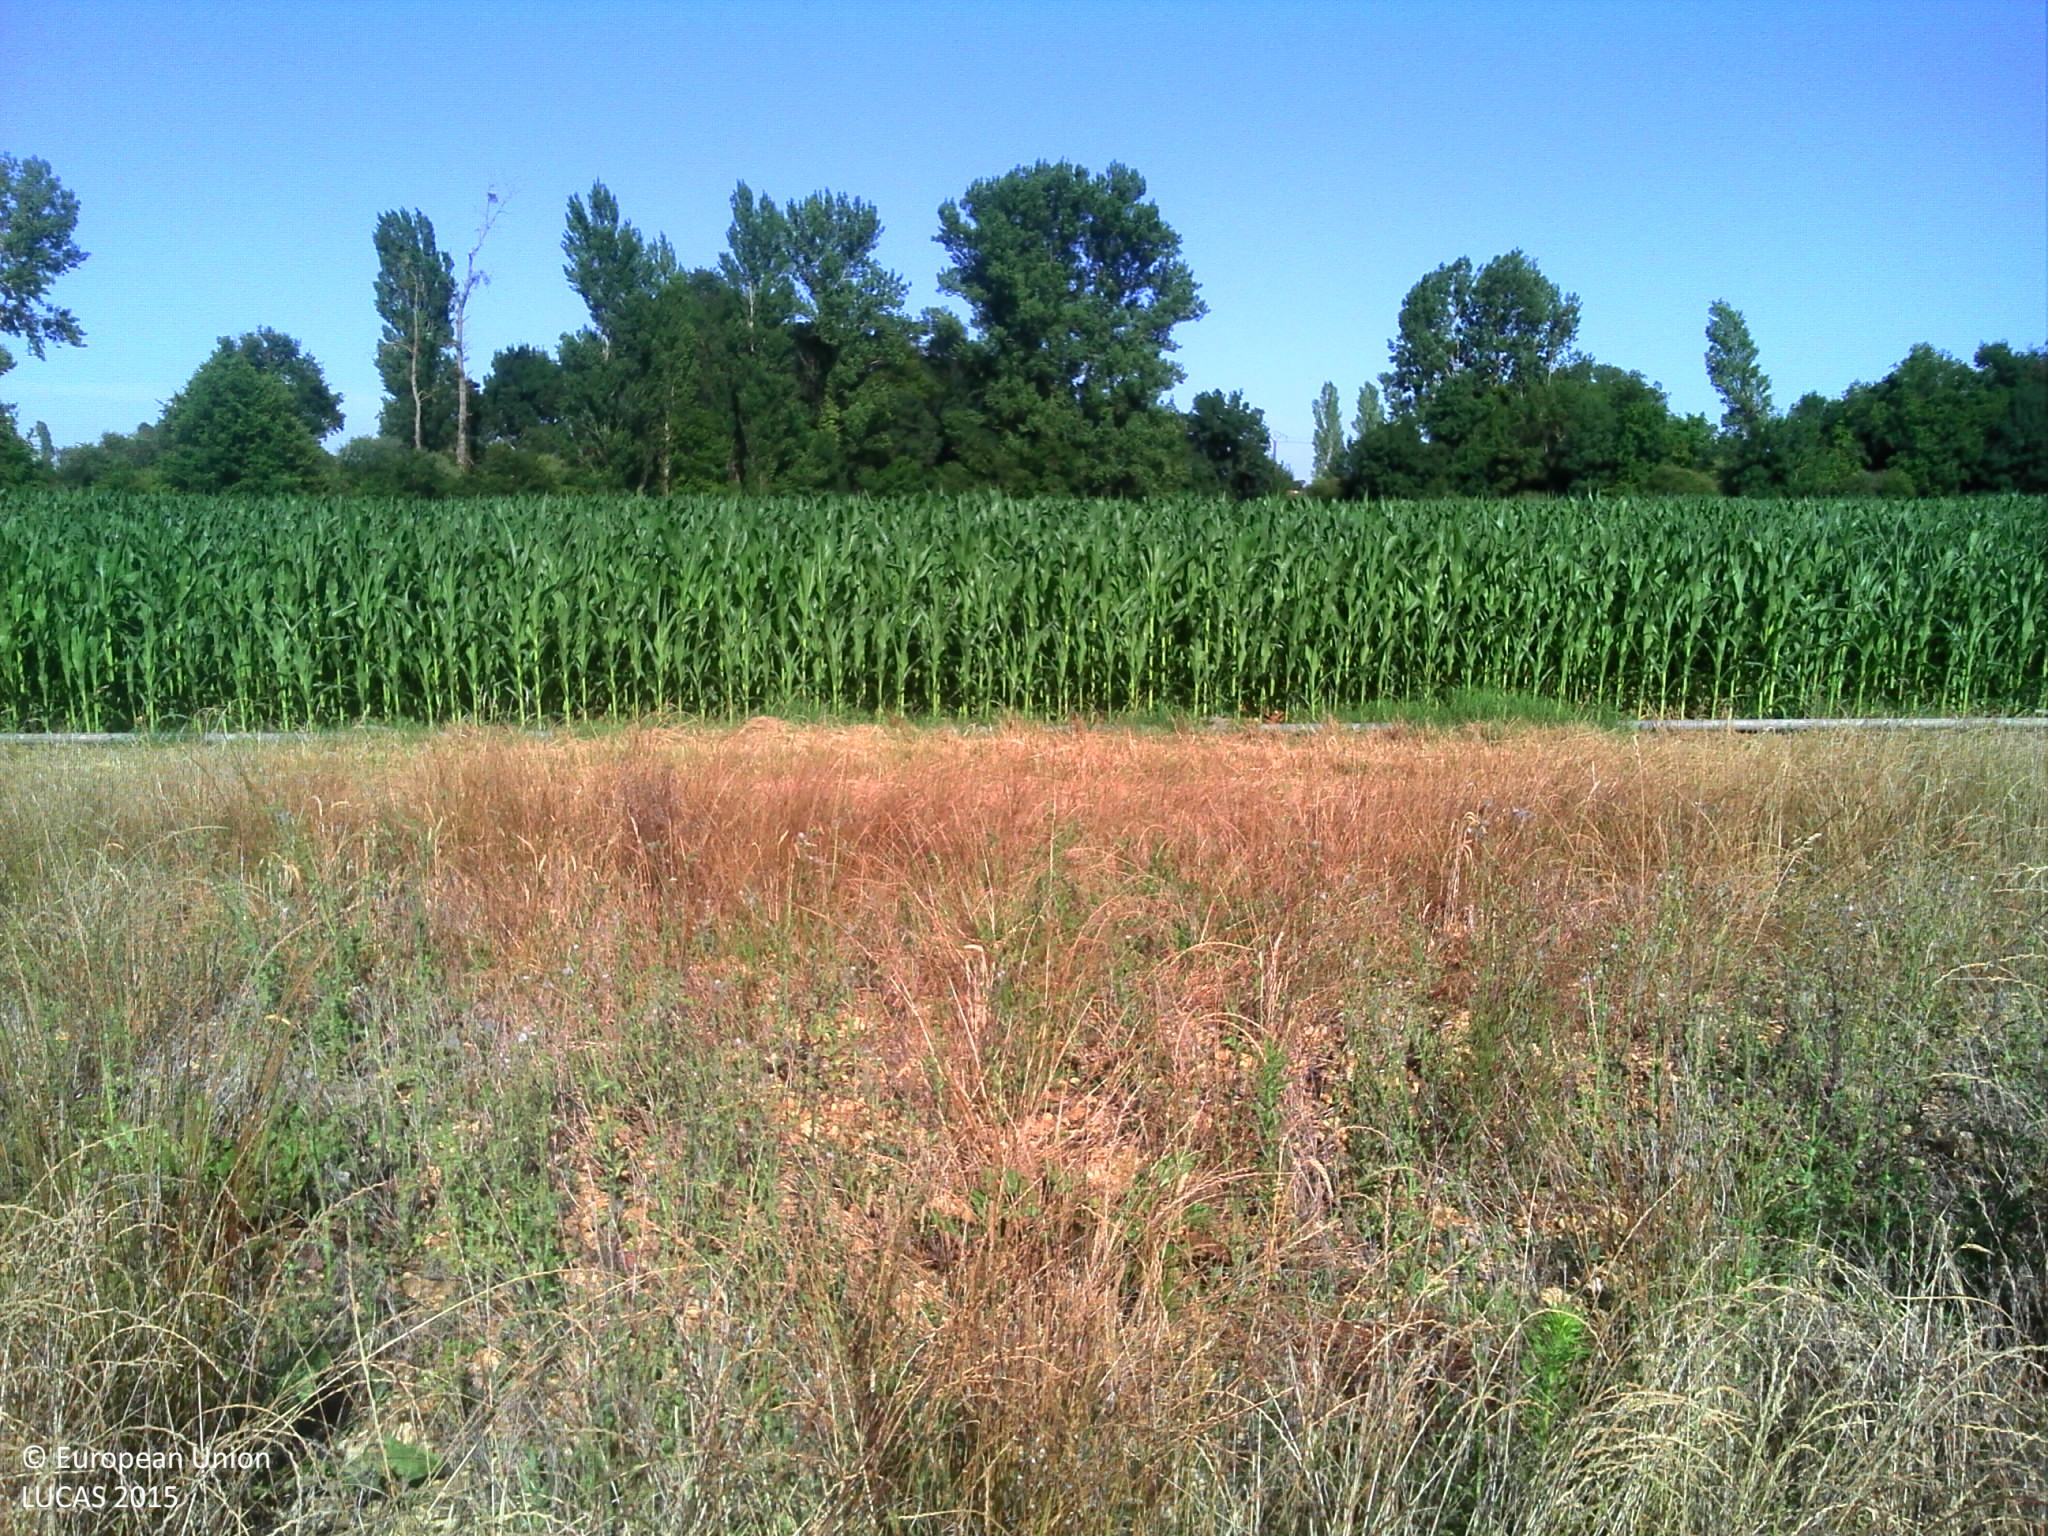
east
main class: Grassland
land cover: Spontaneously vegetated surfaces
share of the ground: > 75 %
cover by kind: herbaceous plants 100 %
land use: Agriculture (excluding fallow land and kitchen gardens)
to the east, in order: Spontaneously vegetated surfaces; Tracks; Maize; Grassland without tree/shrub cover; Inland fresh running water; Broadleaved woodland; Grassland without tree/shrub cover; Common wheat
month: June
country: FR
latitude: 45.5260
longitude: -0.6630
